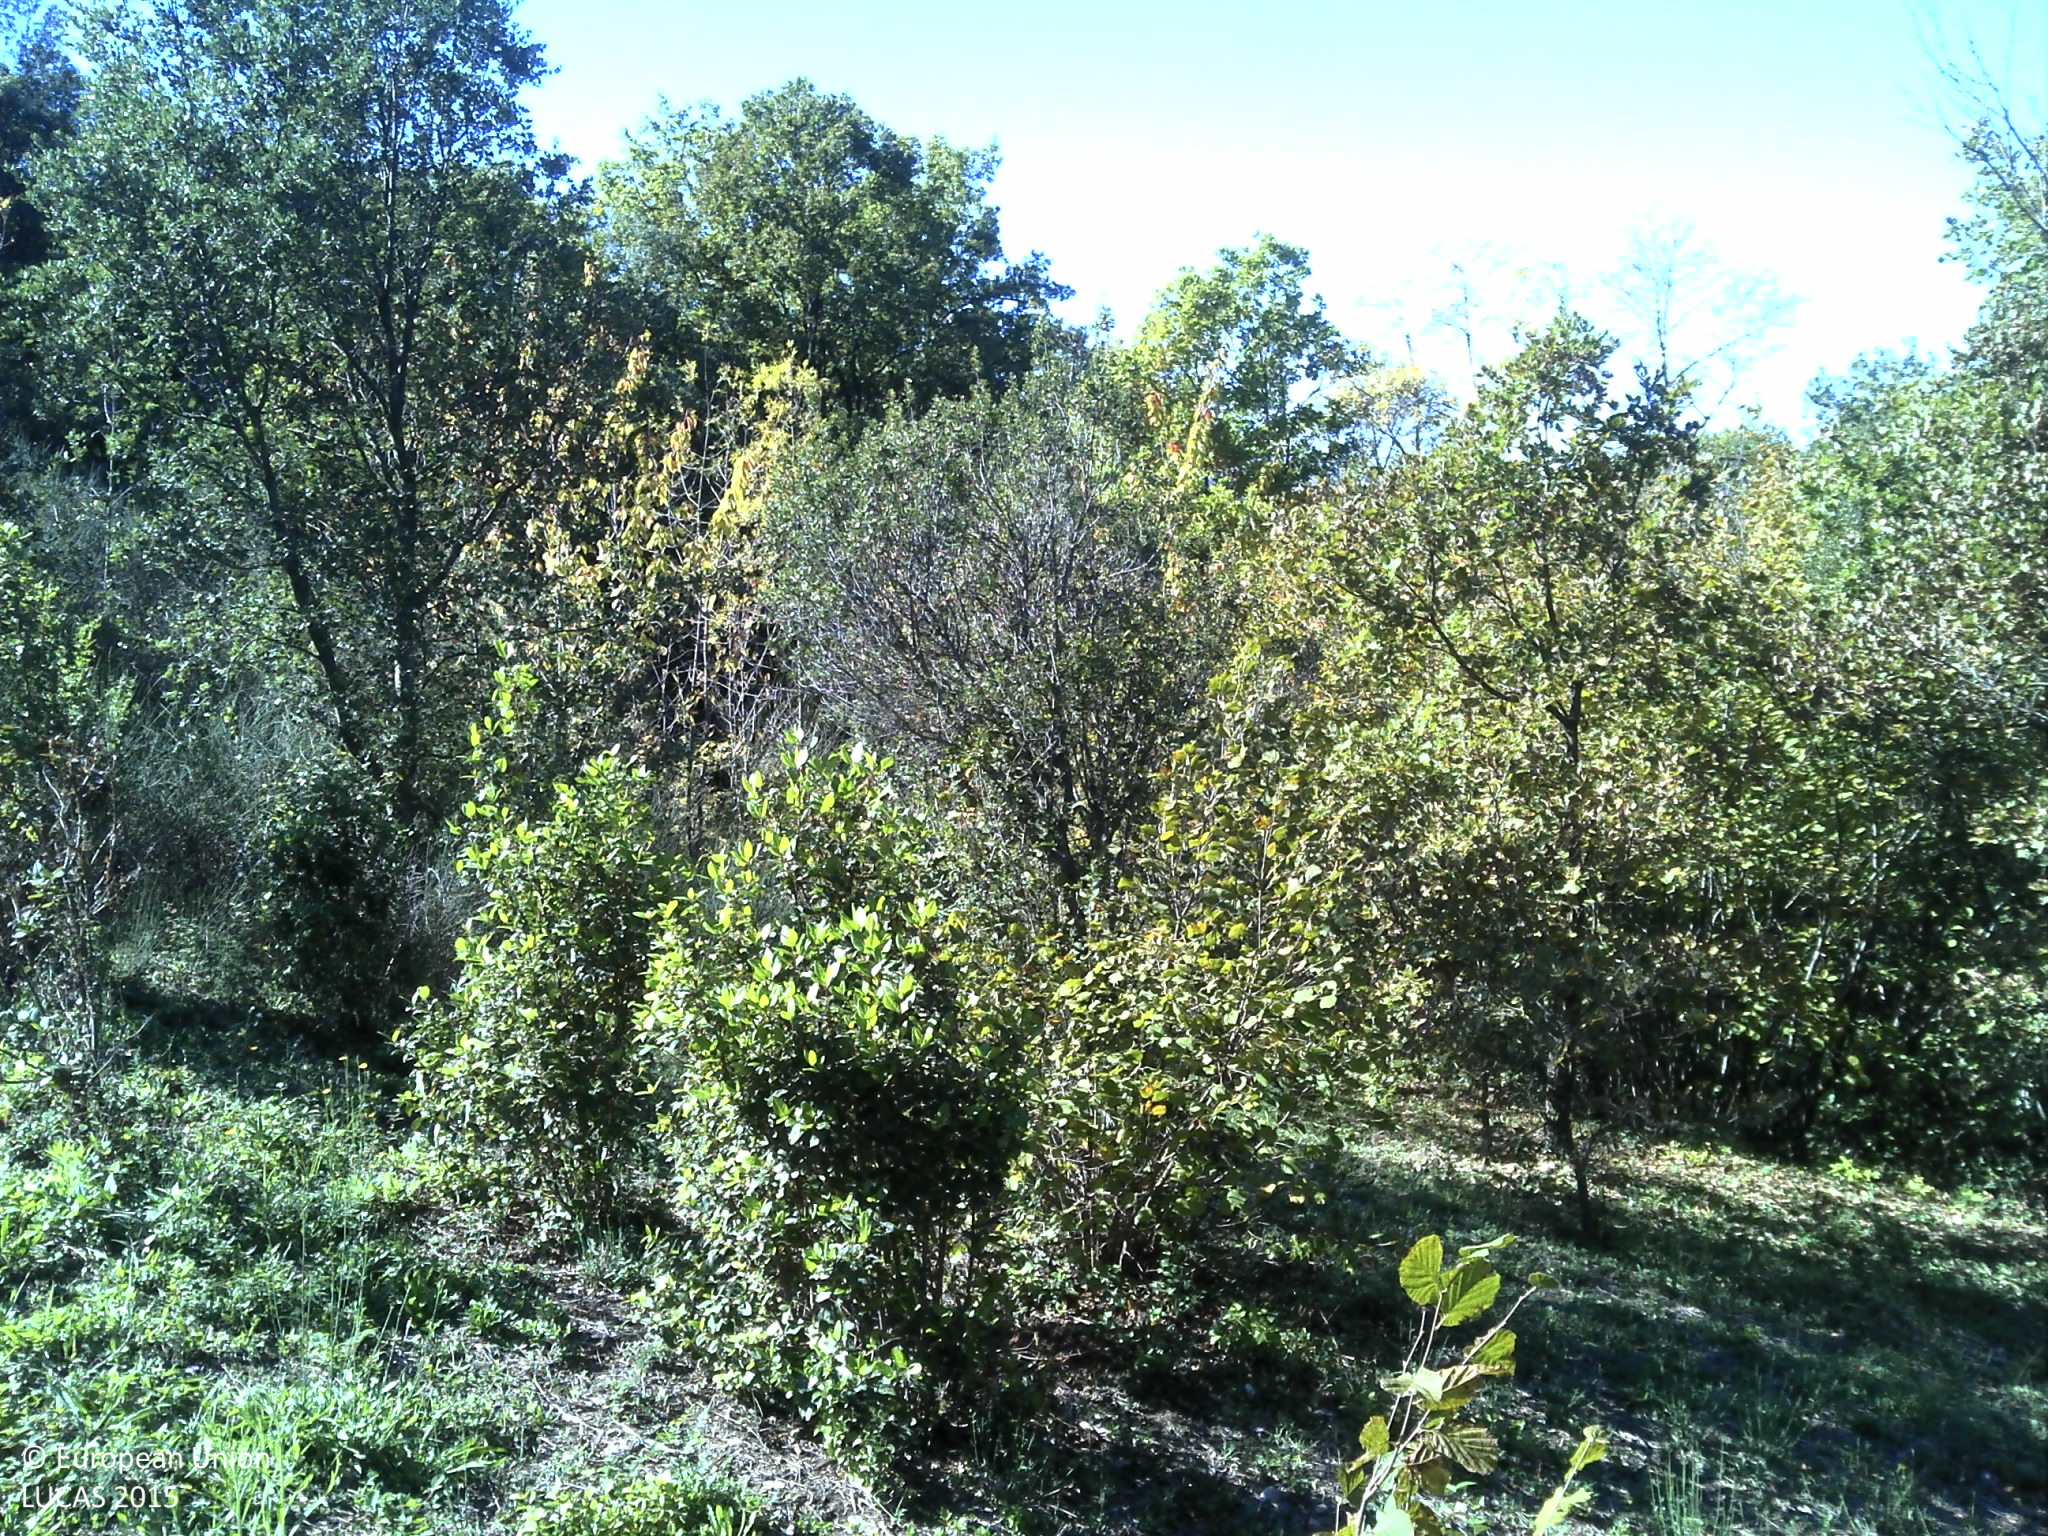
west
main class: Woodland
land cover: Broadleaved woodland
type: mesophytic deciduous forest
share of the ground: 50 - 75 %
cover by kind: broadleaved forest trees 55 %, herbaceous plants 40 %, shrubs 5 %
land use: Forestry
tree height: > 5 m
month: October
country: FR
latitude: 43.5997
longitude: 3.1577
